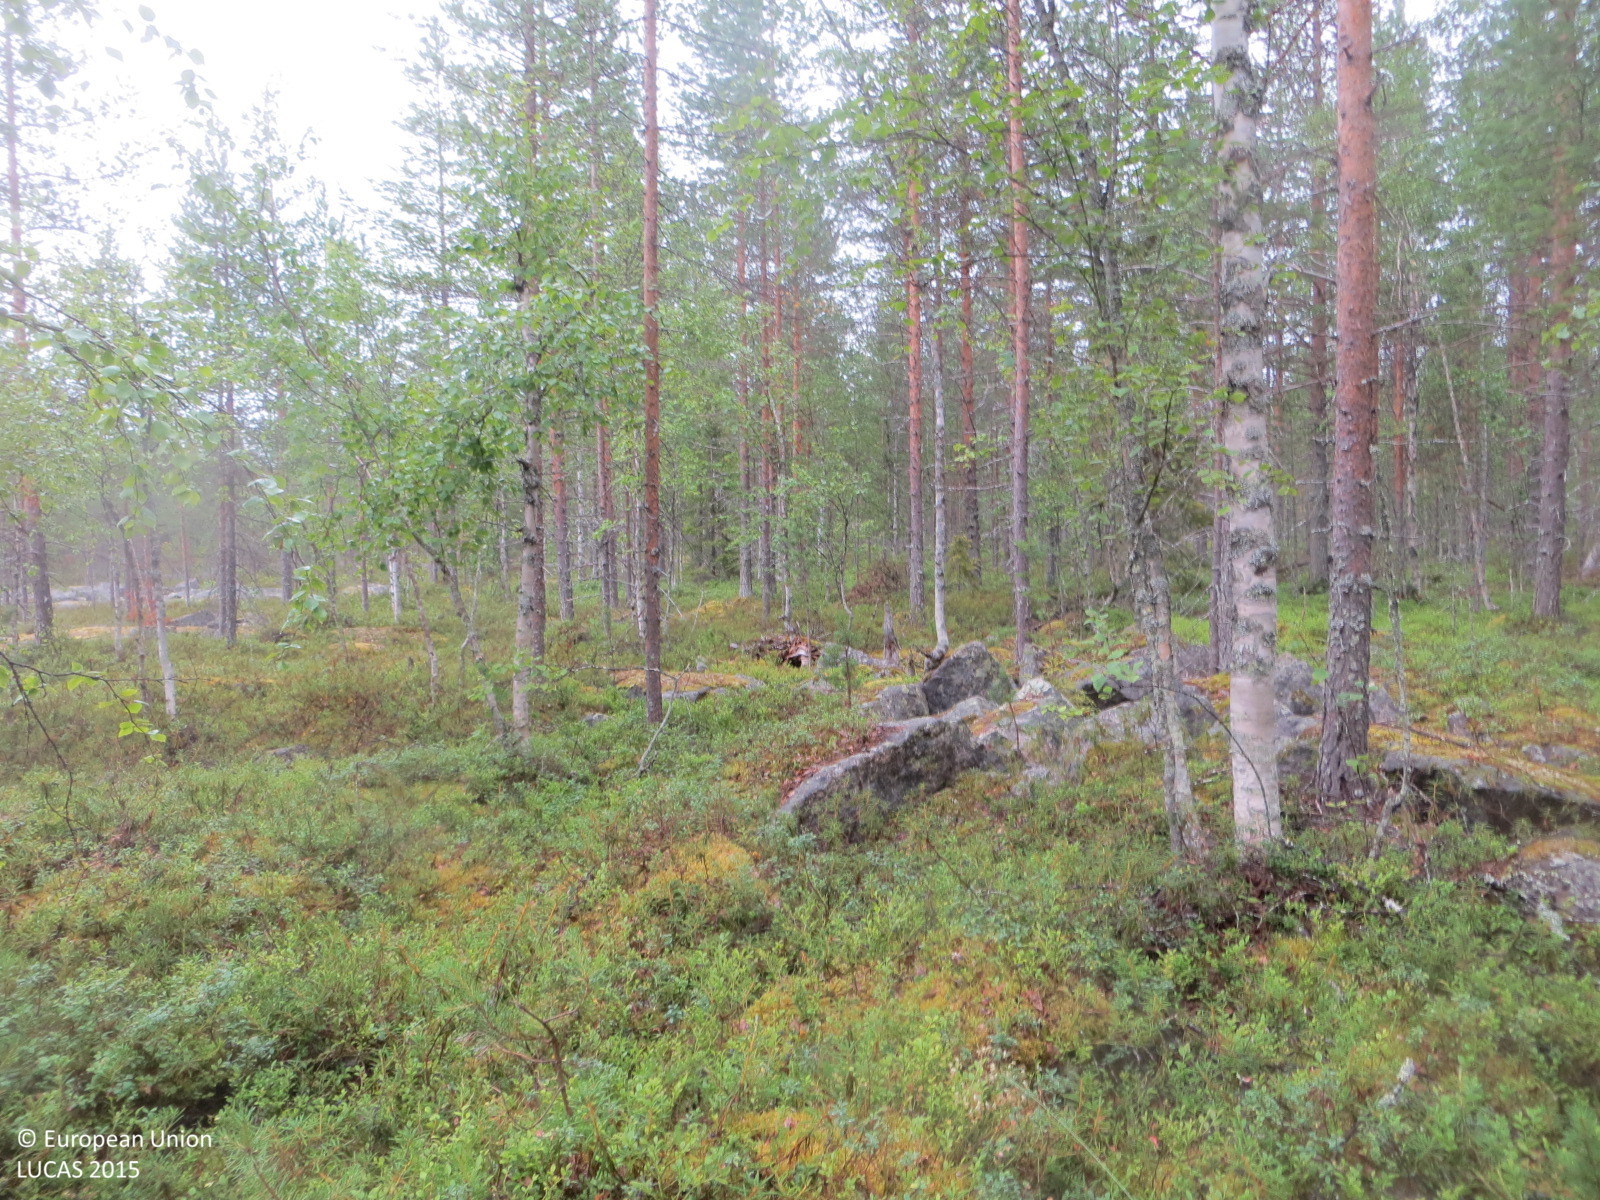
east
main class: Woodland
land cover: Pine dominated mixed woodland
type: boreal forest
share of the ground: 50 - 75 %
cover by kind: shrubs 50 %, coniferous forest trees 25 %, broadleaved forest trees 25 %
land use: Forestry
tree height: > 5 m
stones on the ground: 25 - 50 %
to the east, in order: Pine dominated mixed woodland; Other bare soil; Pine dominated coniferous woodland; Other mixed woodland
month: August
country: FI
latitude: 65.9331
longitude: 25.2069
